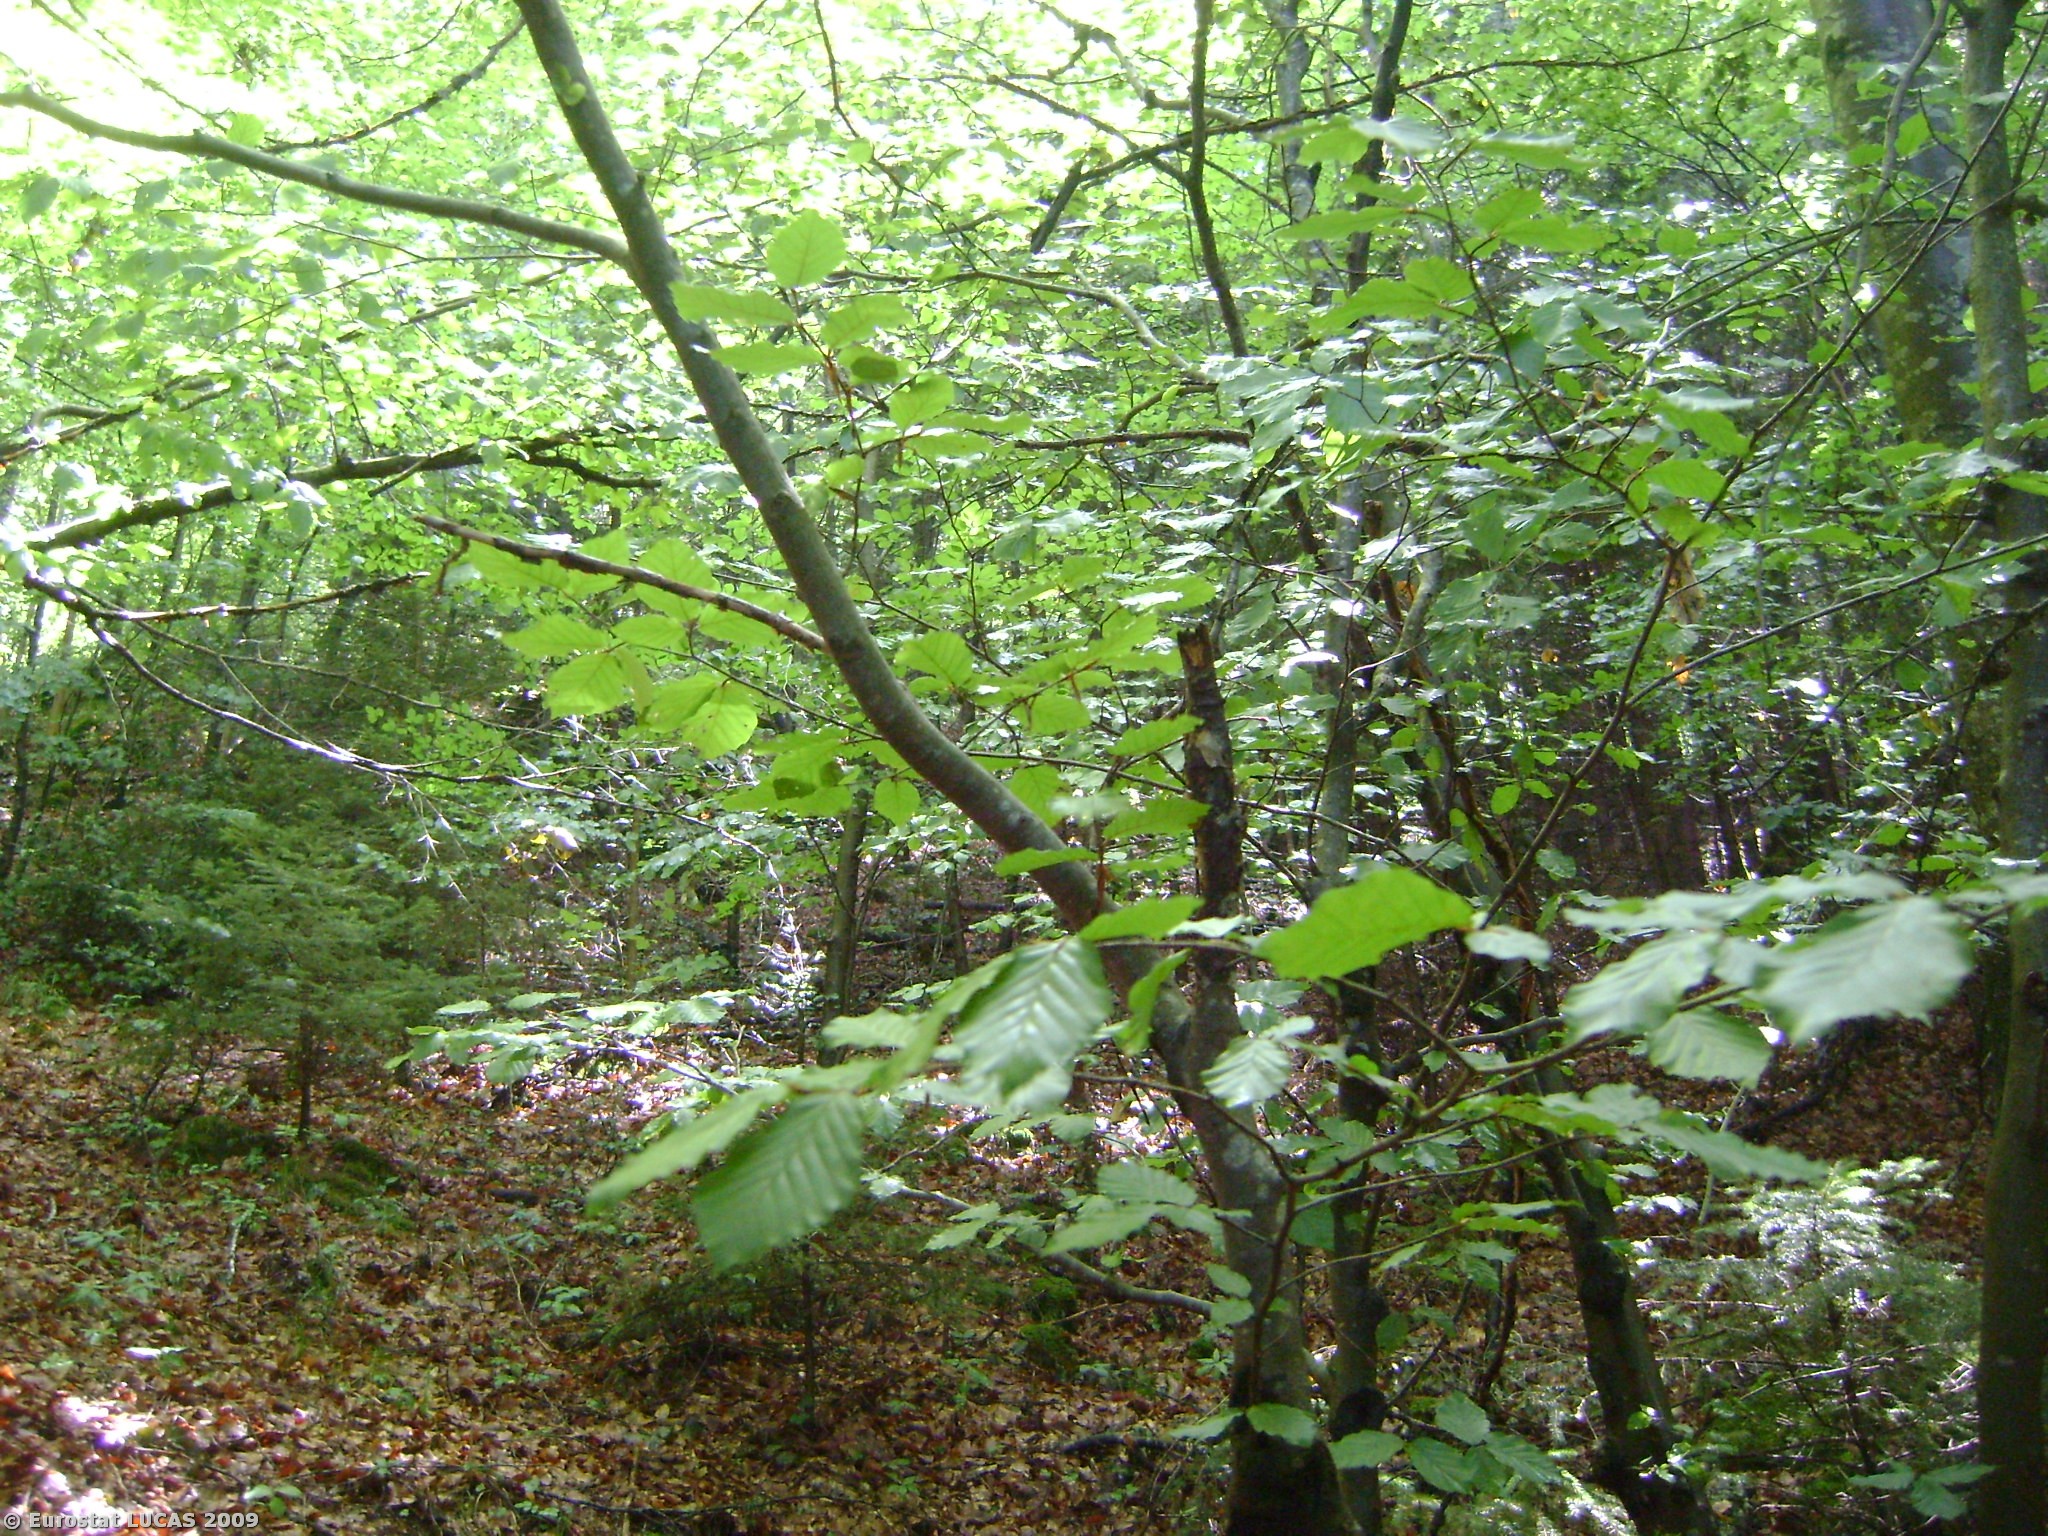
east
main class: Woodland
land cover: Broadleaved woodland
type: beech forest
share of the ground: > 75 %
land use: Forestry
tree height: > 5 m
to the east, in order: Broadleaved woodland; Rock outcrops; Broadleaved woodland; Grassland without tree/shrub cover; Grassland with sparse tree/shrub cover; Electric lines; Grassland with sparse tree/shrub cover
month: August
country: AT
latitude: 47.3051
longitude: 9.6697
